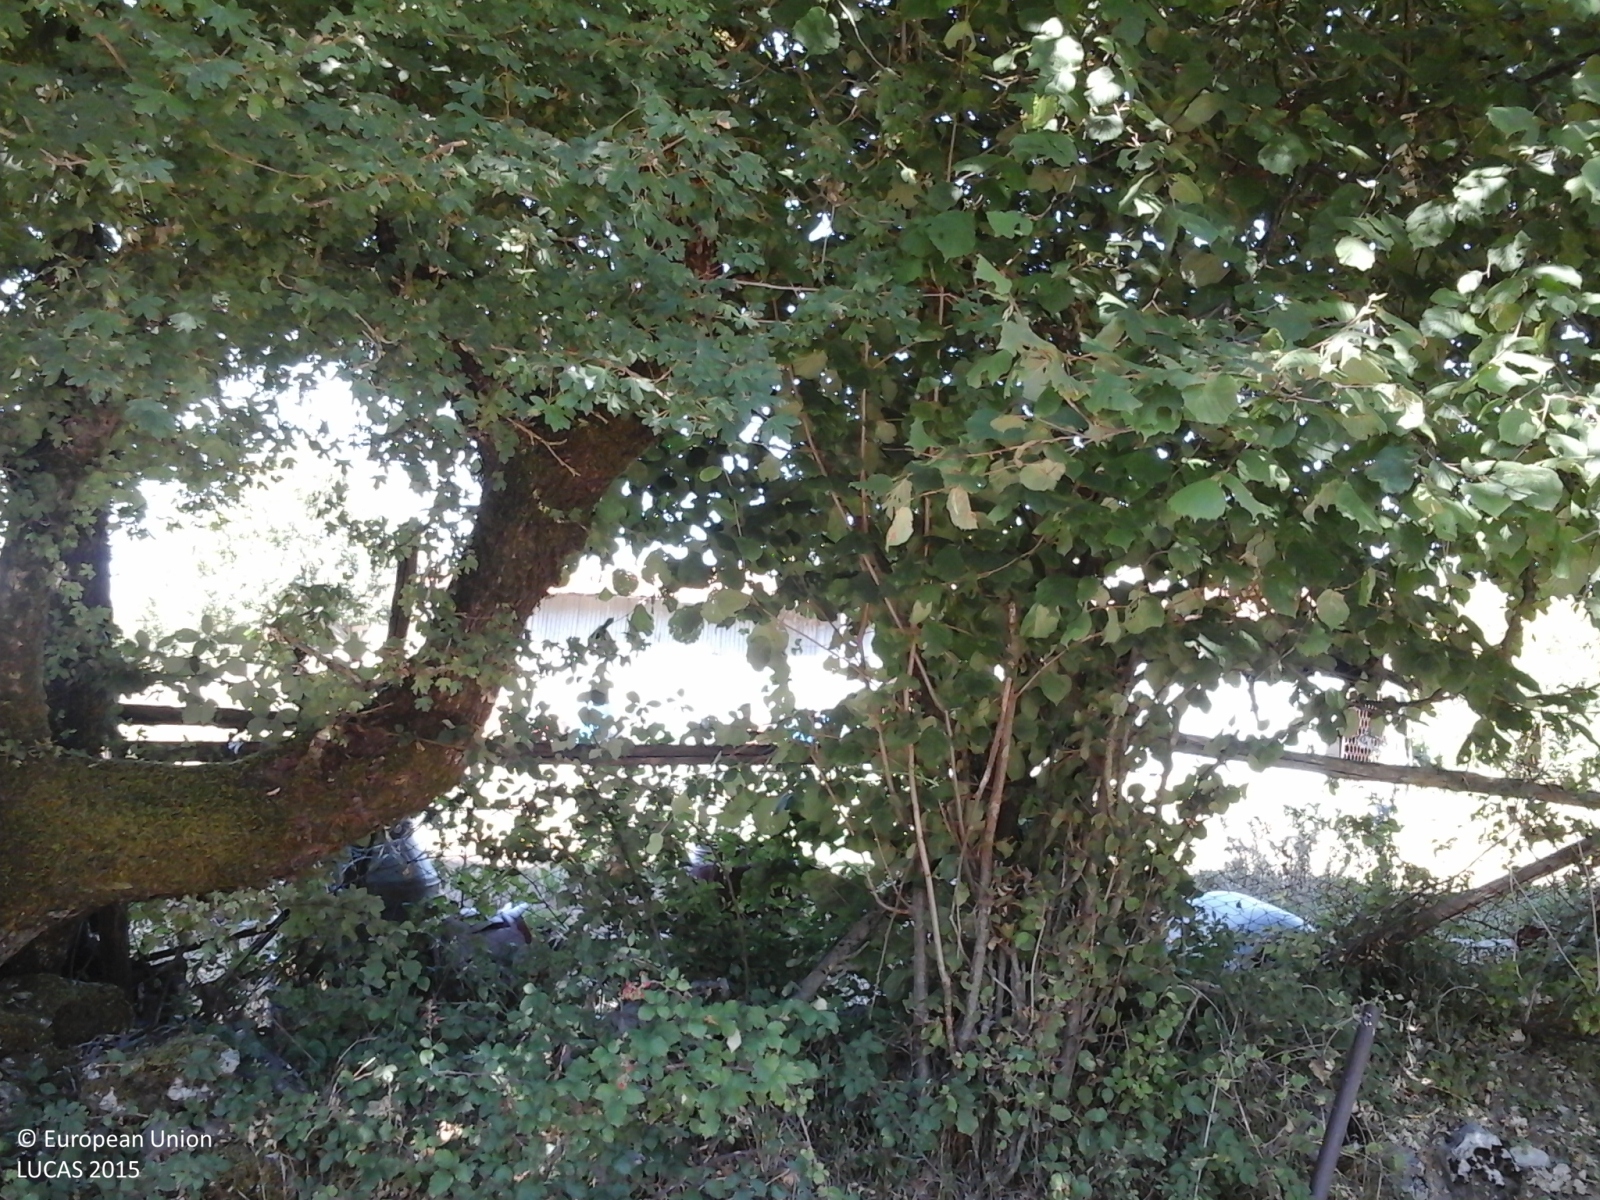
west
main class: Woodland
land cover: Broadleaved woodland
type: thermophilous deciduous forest
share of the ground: > 75 %
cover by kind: broadleaved forest trees 100 %
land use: Forestry
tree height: > 5 m
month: August
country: IT
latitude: 41.9070
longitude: 12.9188
